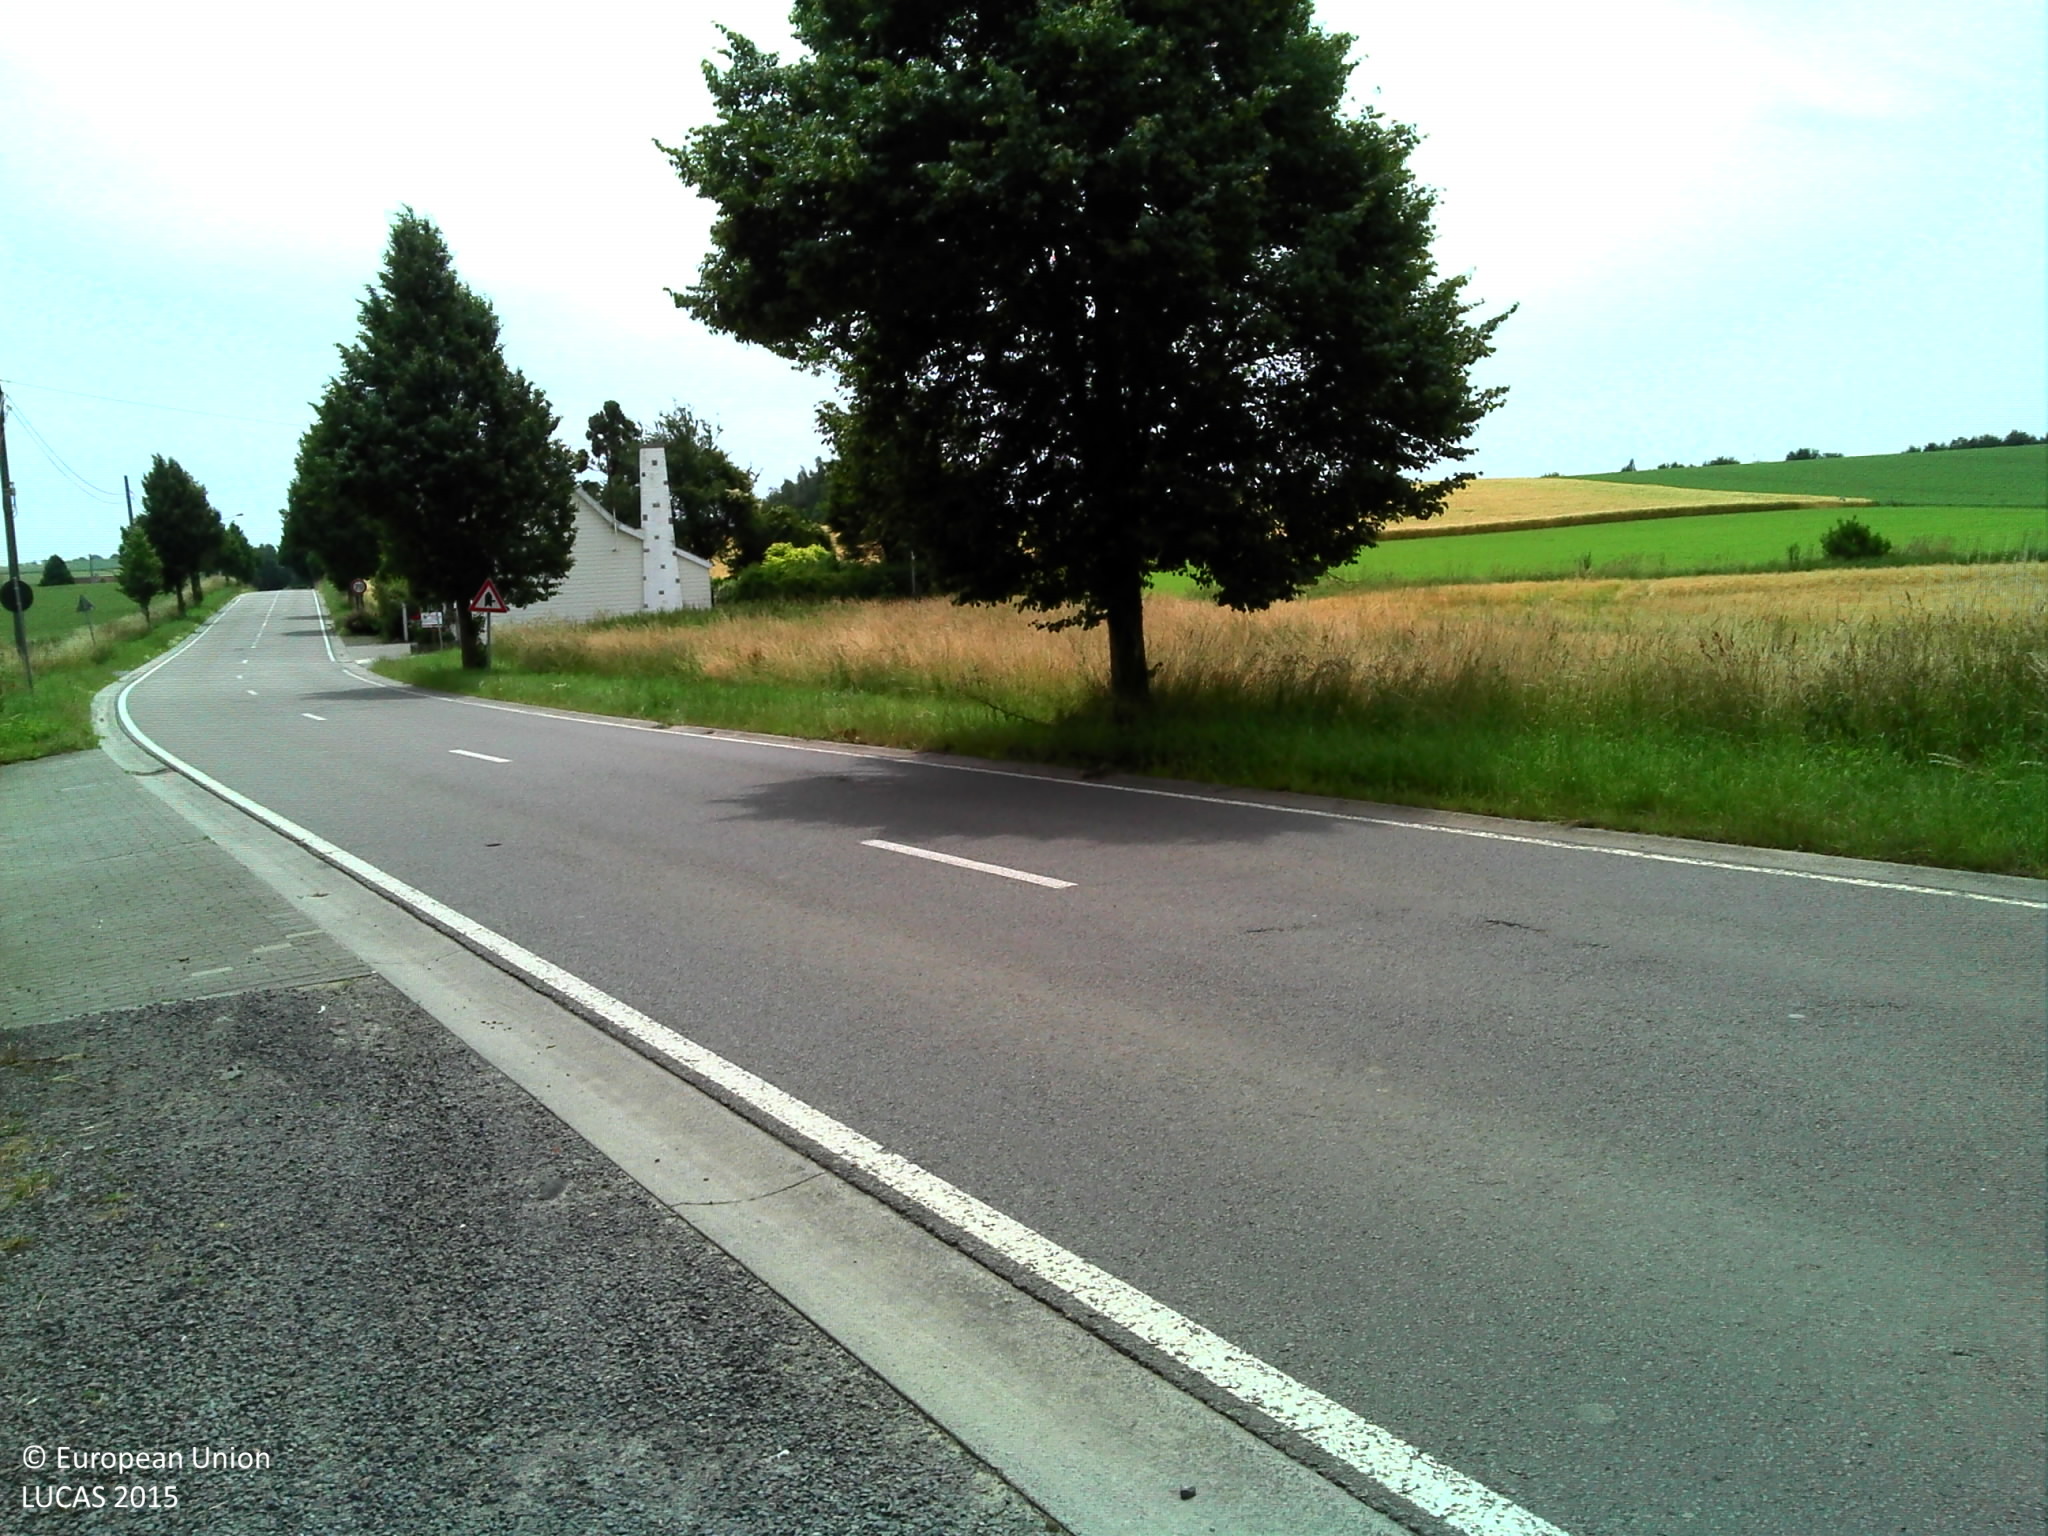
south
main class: Grassland
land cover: Grassland without tree/shrub cover
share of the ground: > 75 %
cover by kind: herbaceous plants 100 %
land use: Amenities, museums, leisure
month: June
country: BE
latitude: 50.6429
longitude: 3.7286
